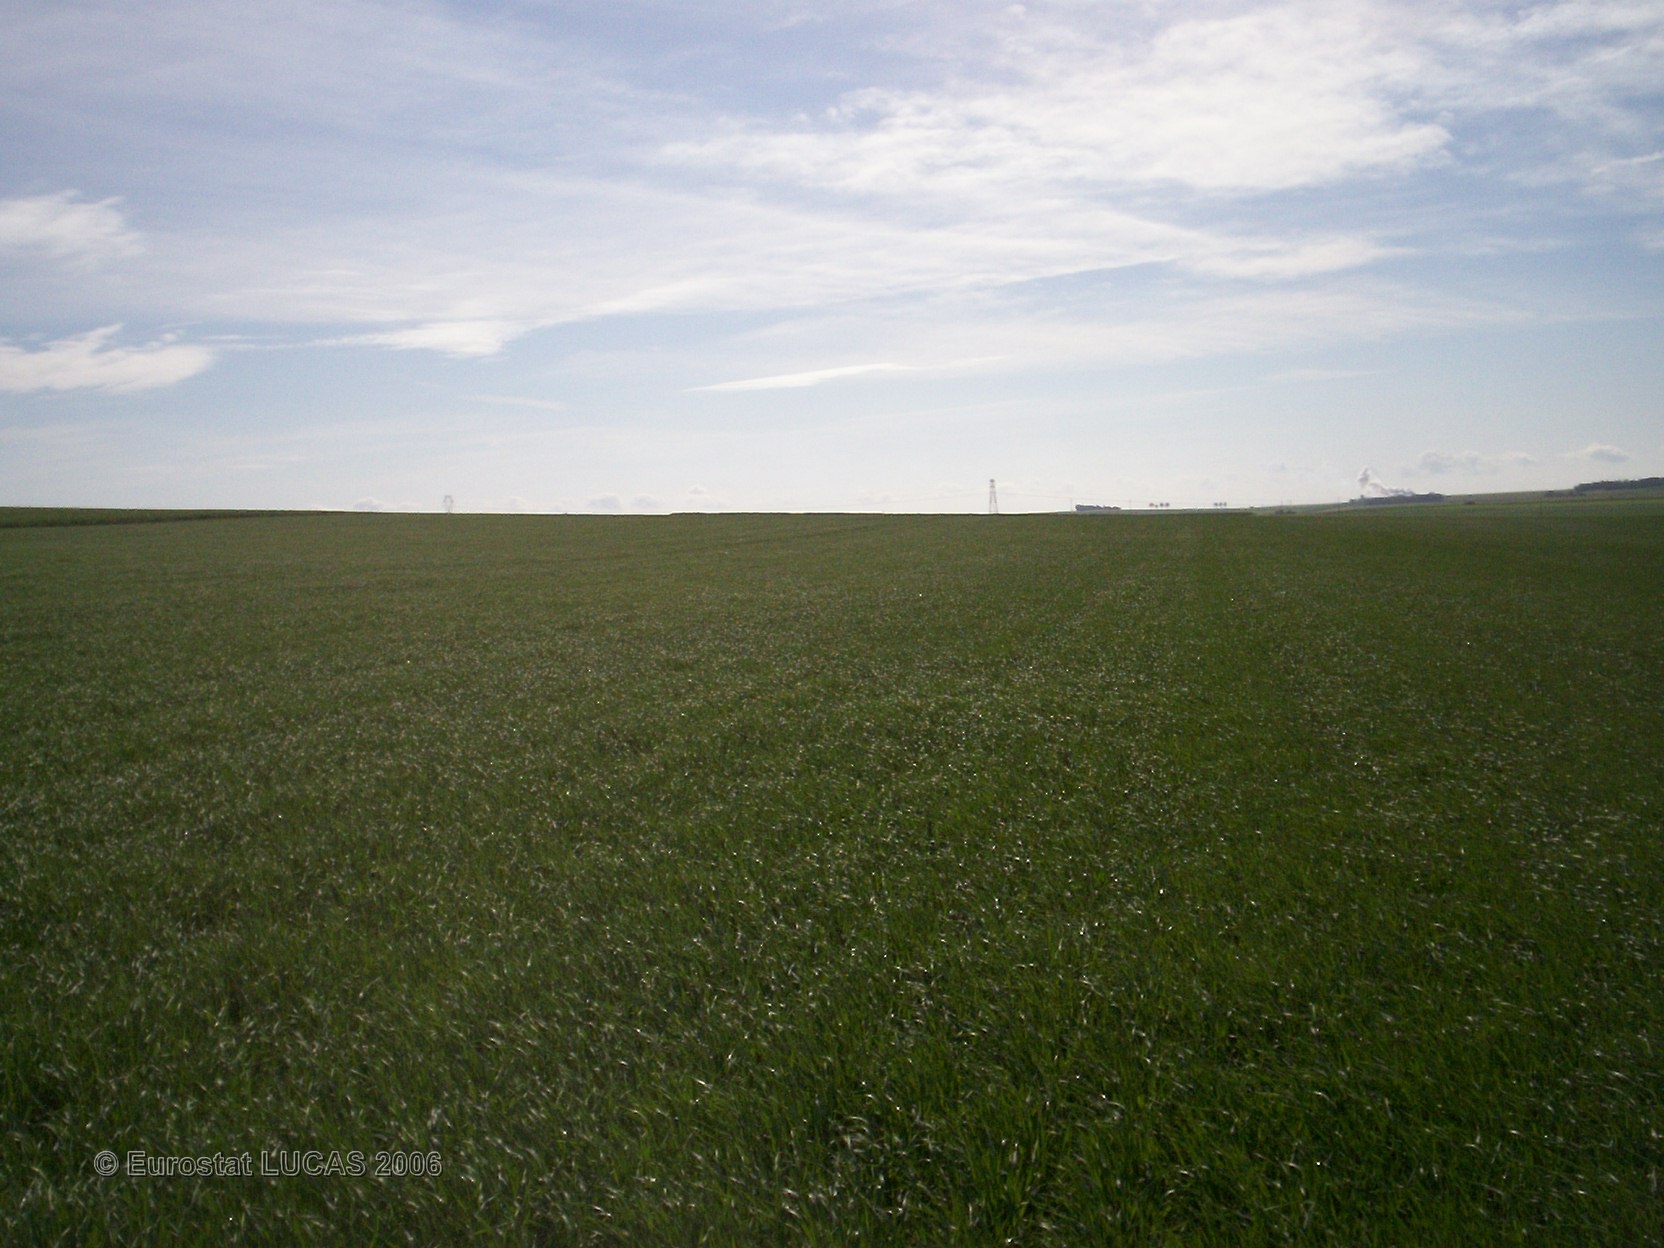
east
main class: Cropland
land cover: Barley
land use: Agriculture (excluding fallow land and kitchen gardens)
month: May
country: FR
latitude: 49.4343
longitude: 4.4113
